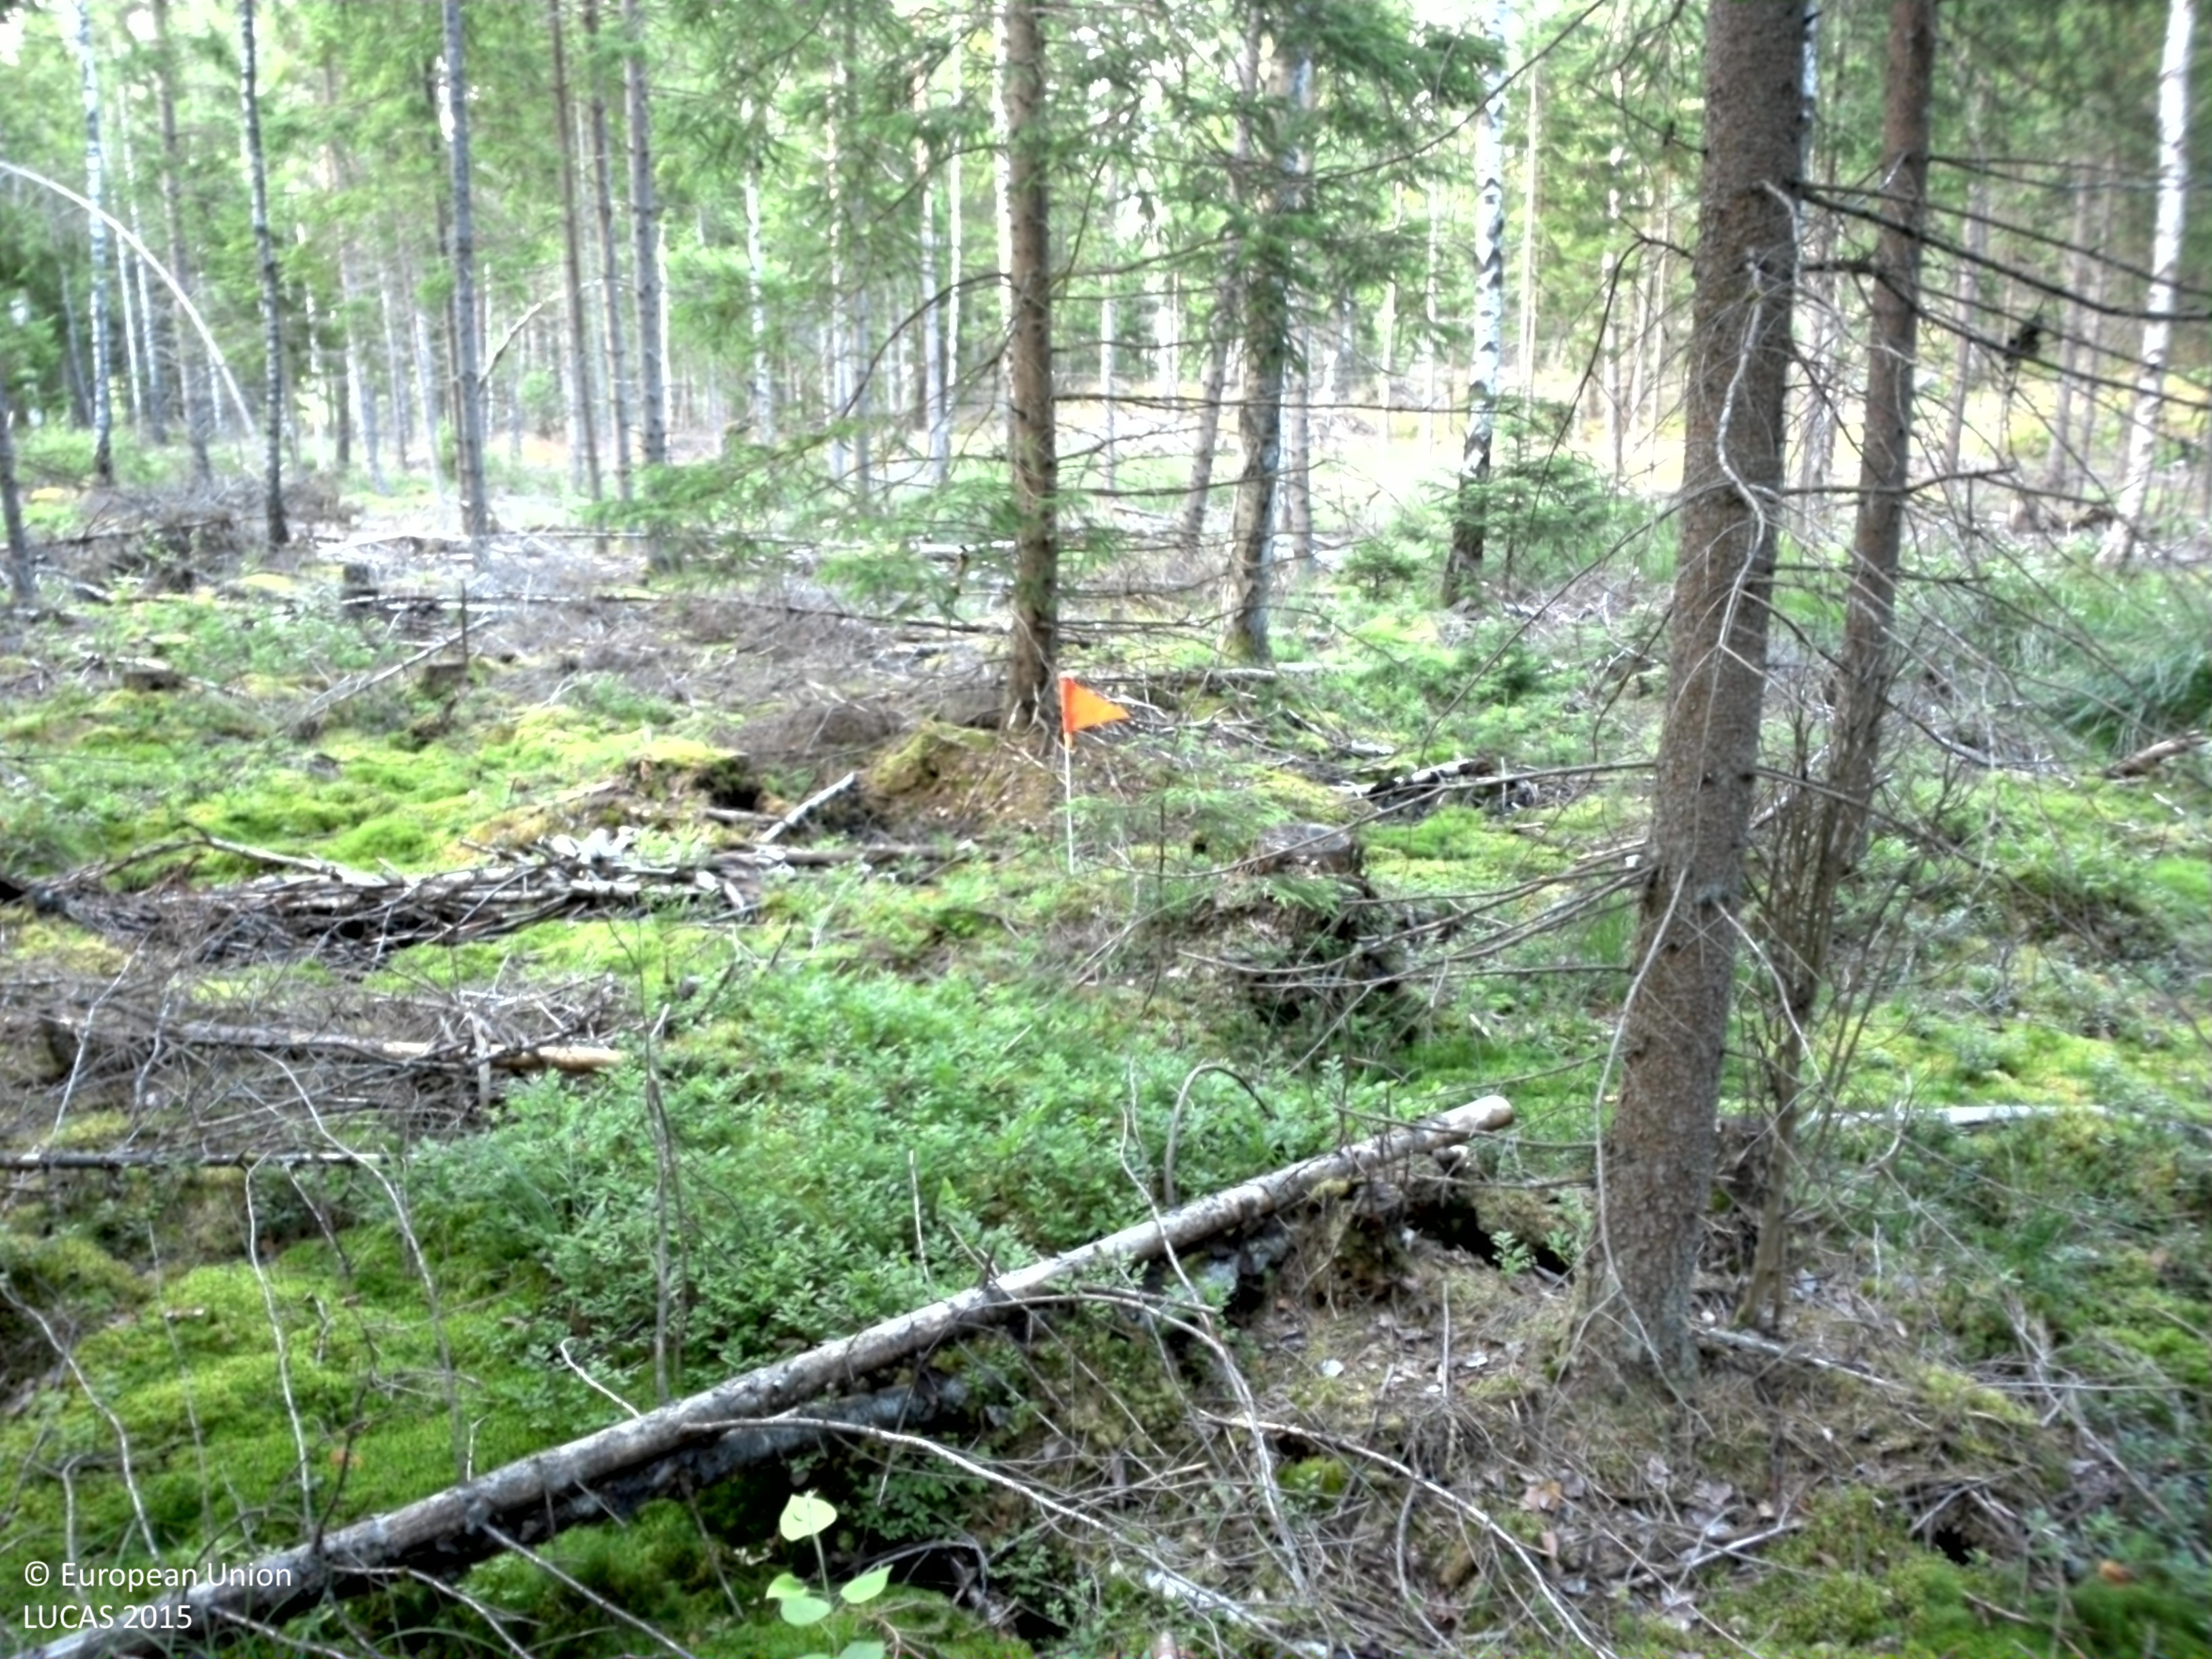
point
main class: Woodland
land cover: Spruce dominated coniferous woodland
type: boreal forest
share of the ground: 25 - 50 %
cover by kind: coniferous forest trees 45 %, lichens and mosses 35 %, broadleaved forest trees 10 %, herbaceous plants 10 %
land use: Forestry
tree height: > 5 m
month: July
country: SE
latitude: 56.3907
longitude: 14.6793
